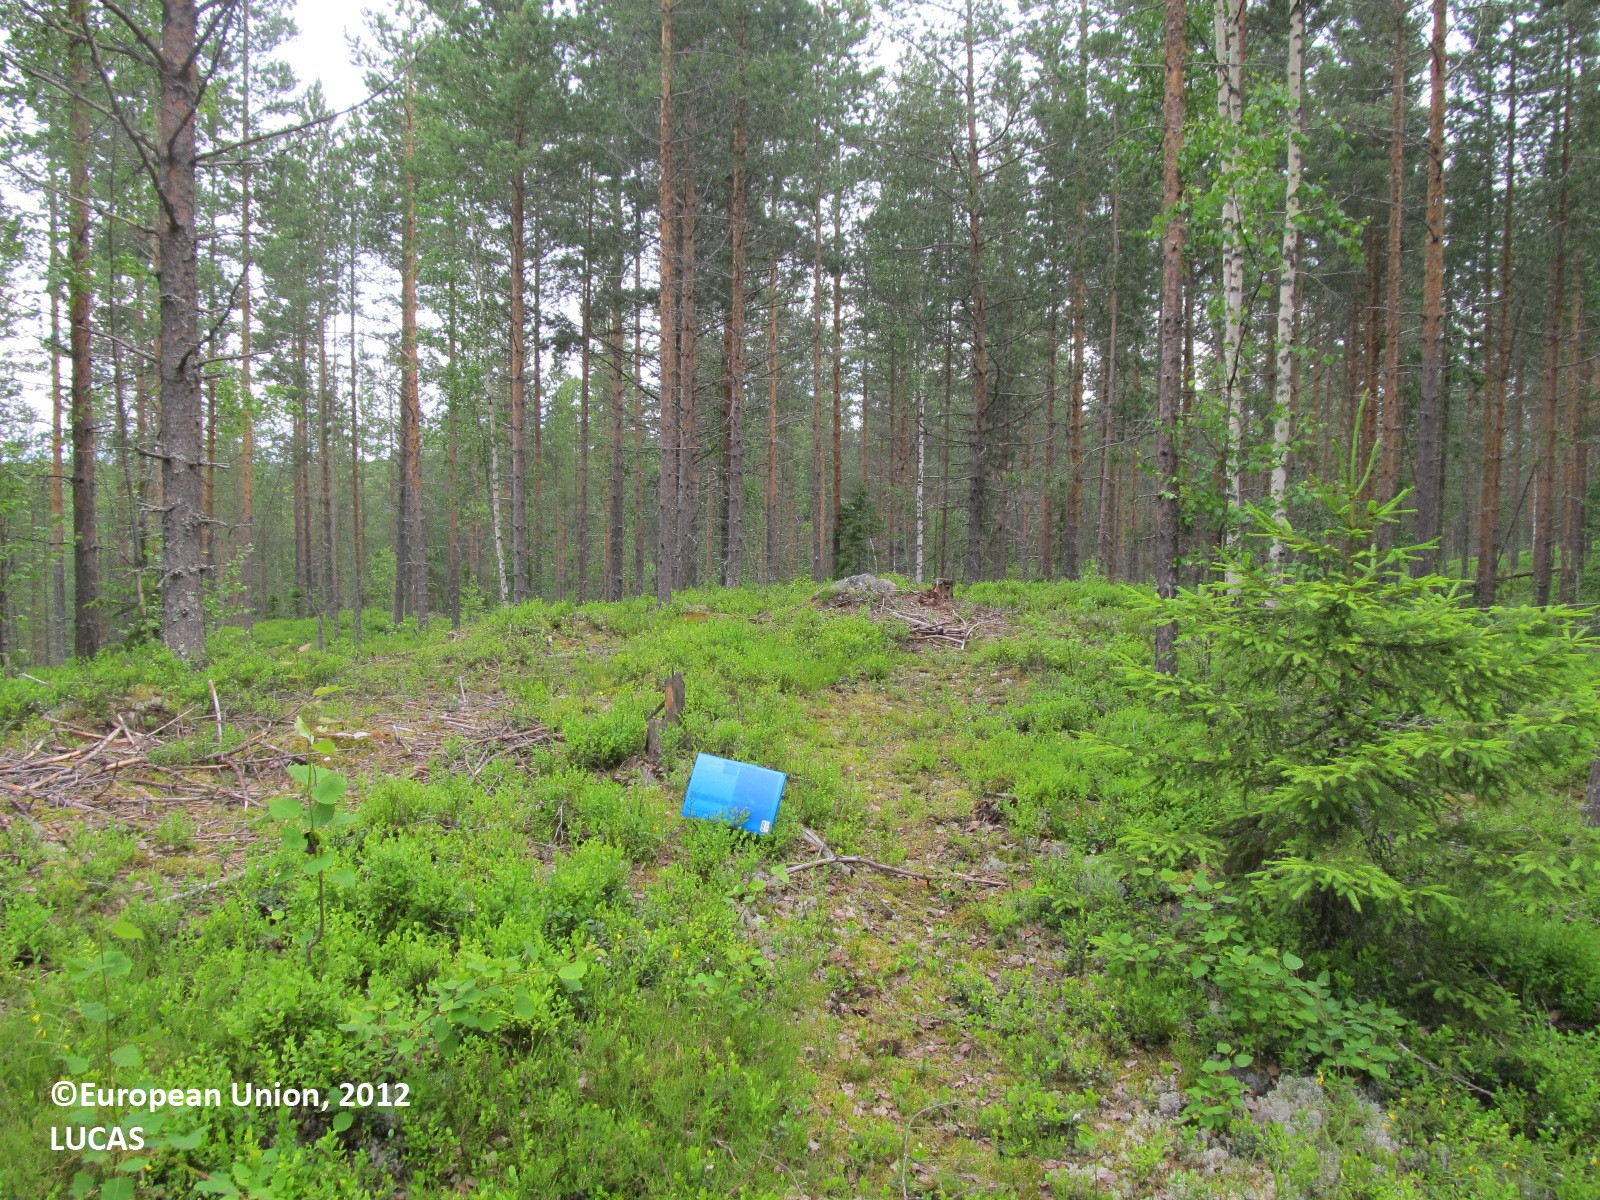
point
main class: Woodland
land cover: Pine dominated coniferous woodland
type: boreal forest
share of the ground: 50 - 75 %
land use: Forestry
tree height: > 5 m
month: June
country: FI
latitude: 62.8403
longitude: 28.8450
